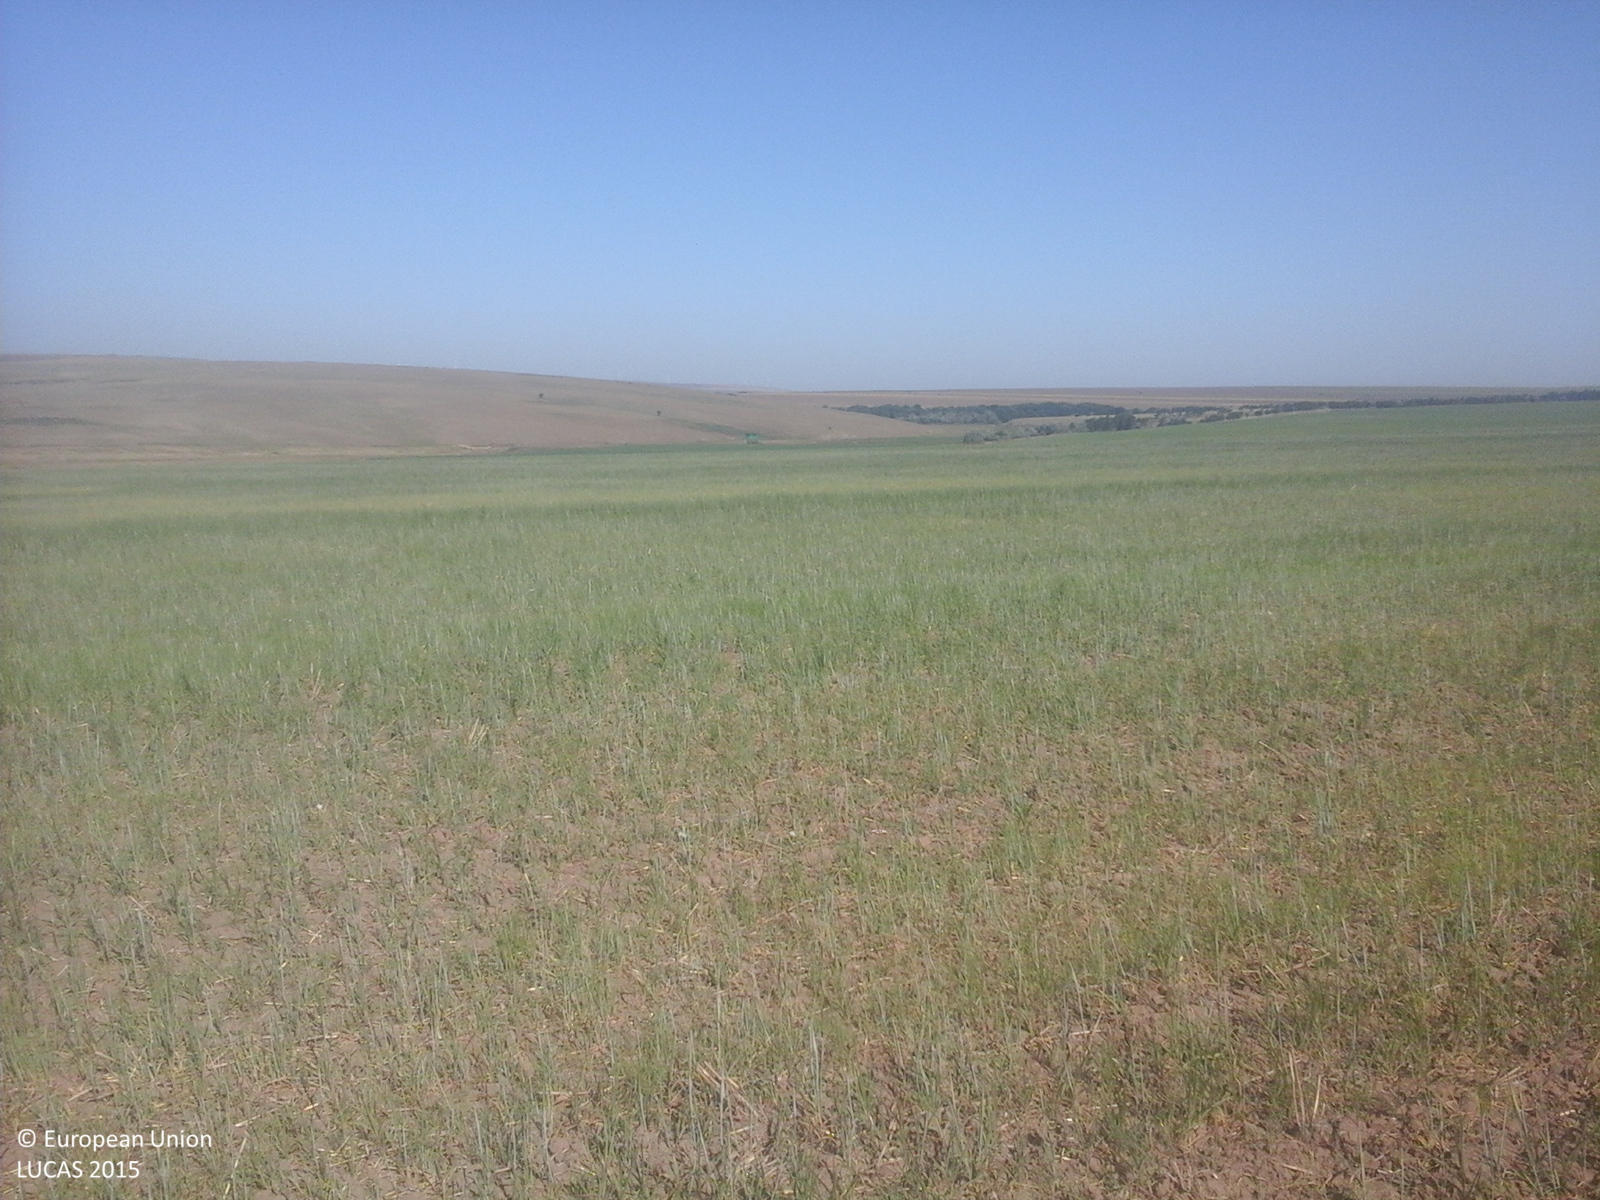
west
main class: Cropland
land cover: Other cereals
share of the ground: > 75 %
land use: Agriculture (excluding fallow land and kitchen gardens)
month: August
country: RO
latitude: 44.5285
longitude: 28.4299
